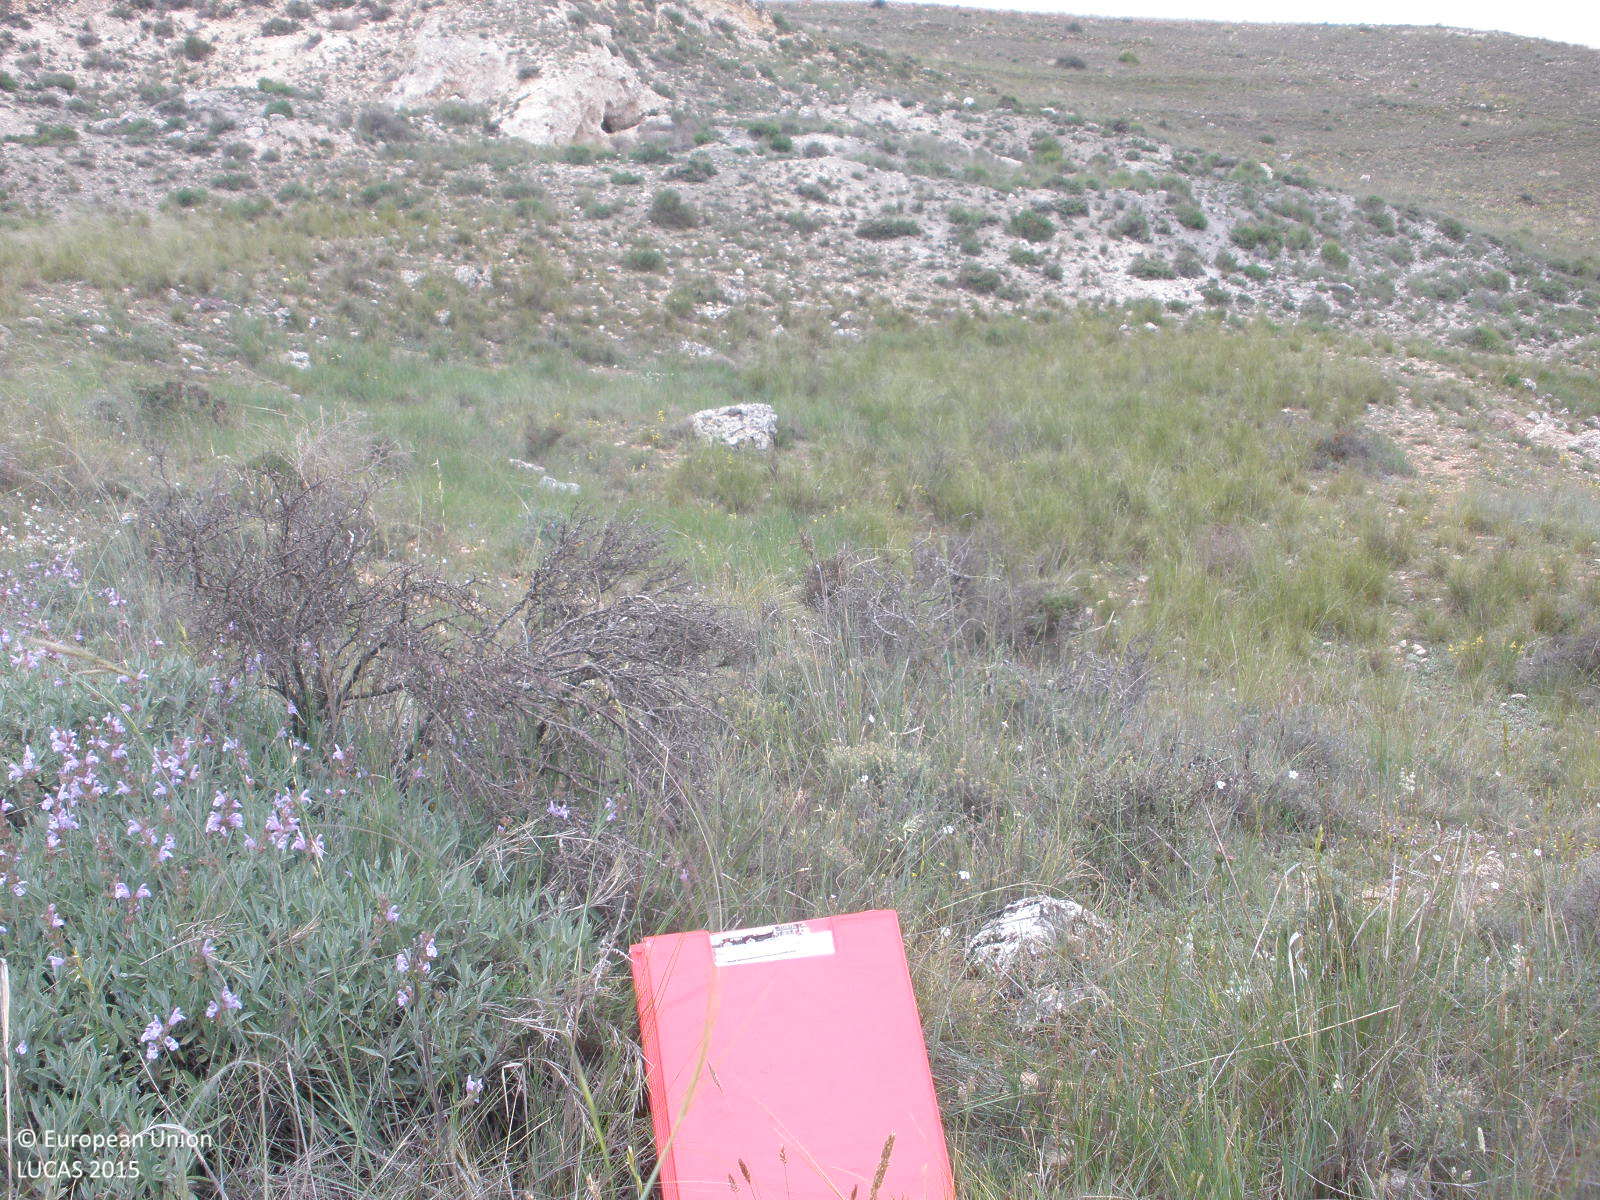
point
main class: Shrubland
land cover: Shrubland without tree cover
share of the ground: 25 - 50 %
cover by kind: herbaceous plants 60 %, shrubs 40 %
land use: Agriculture (excluding fallow land and kitchen gardens)
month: June
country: ES
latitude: 40.5044
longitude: -0.9978
